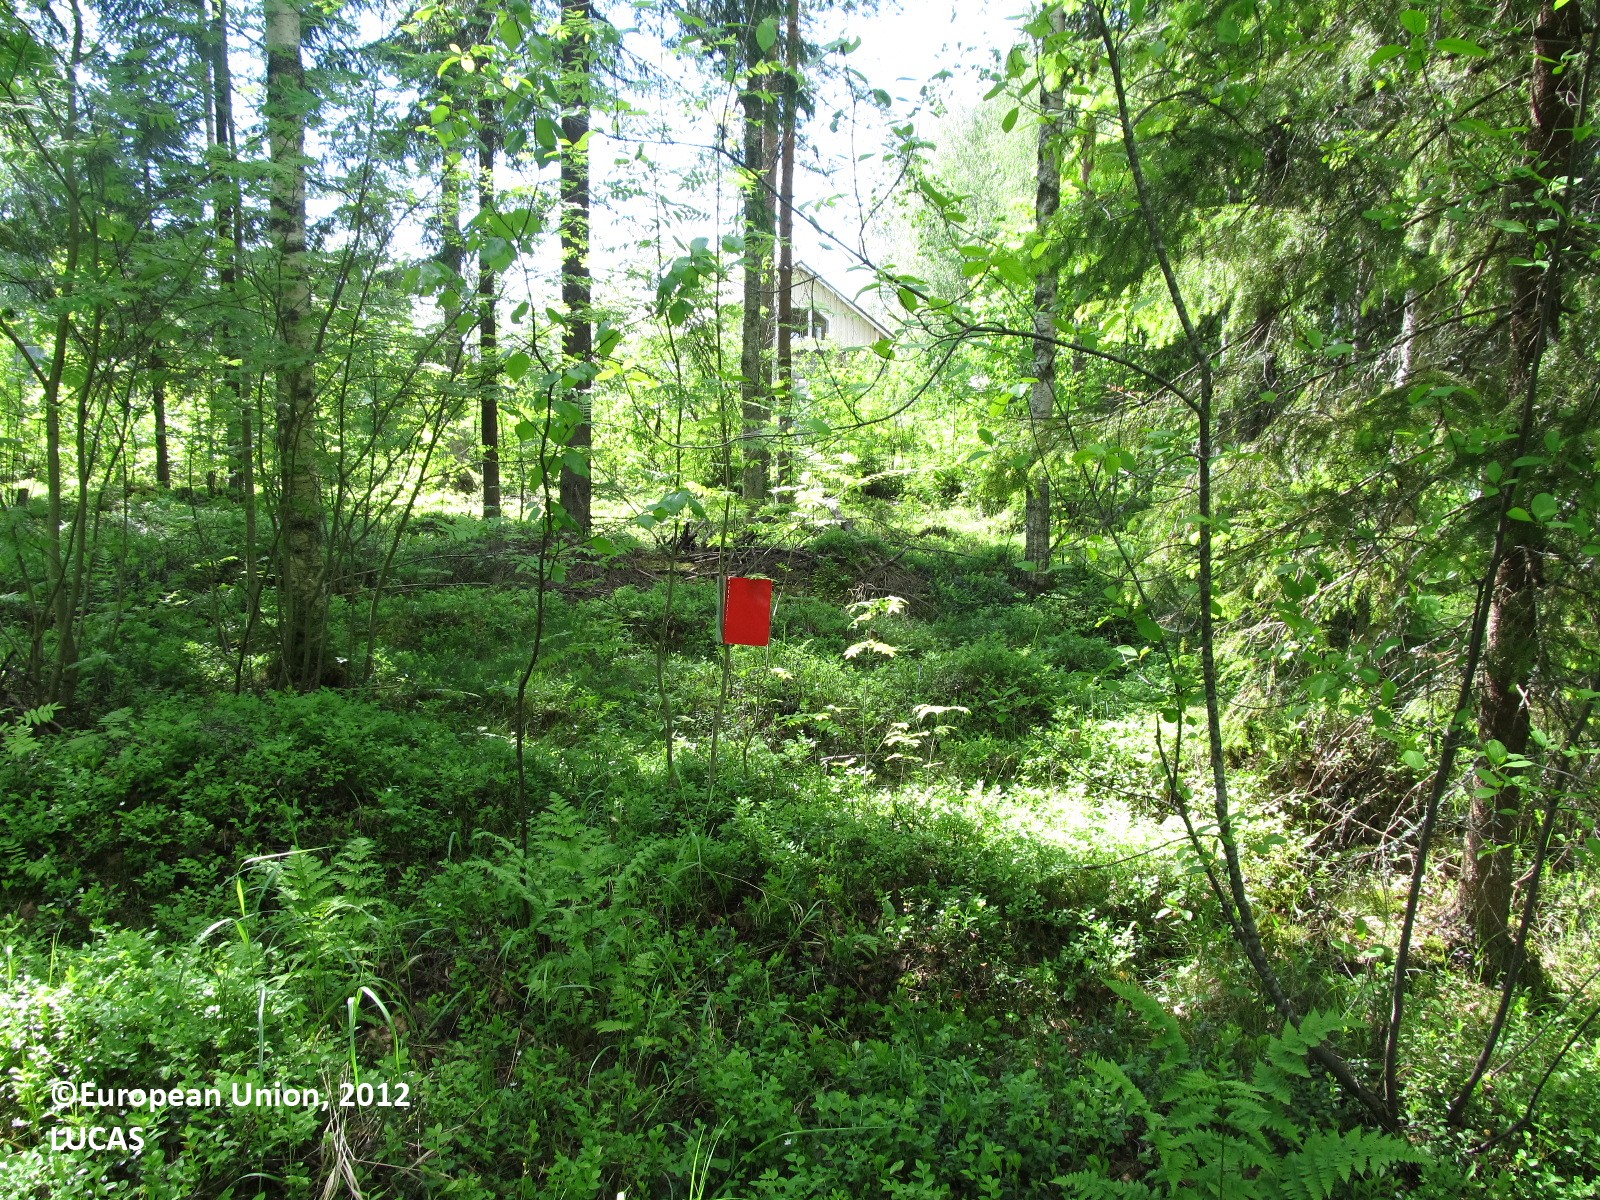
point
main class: Woodland
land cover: Broadleaved woodland
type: boreal forest
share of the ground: 25 - 50 %
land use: Forestry
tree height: > 5 m
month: June
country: FI
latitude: 62.8061
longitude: 27.6038
